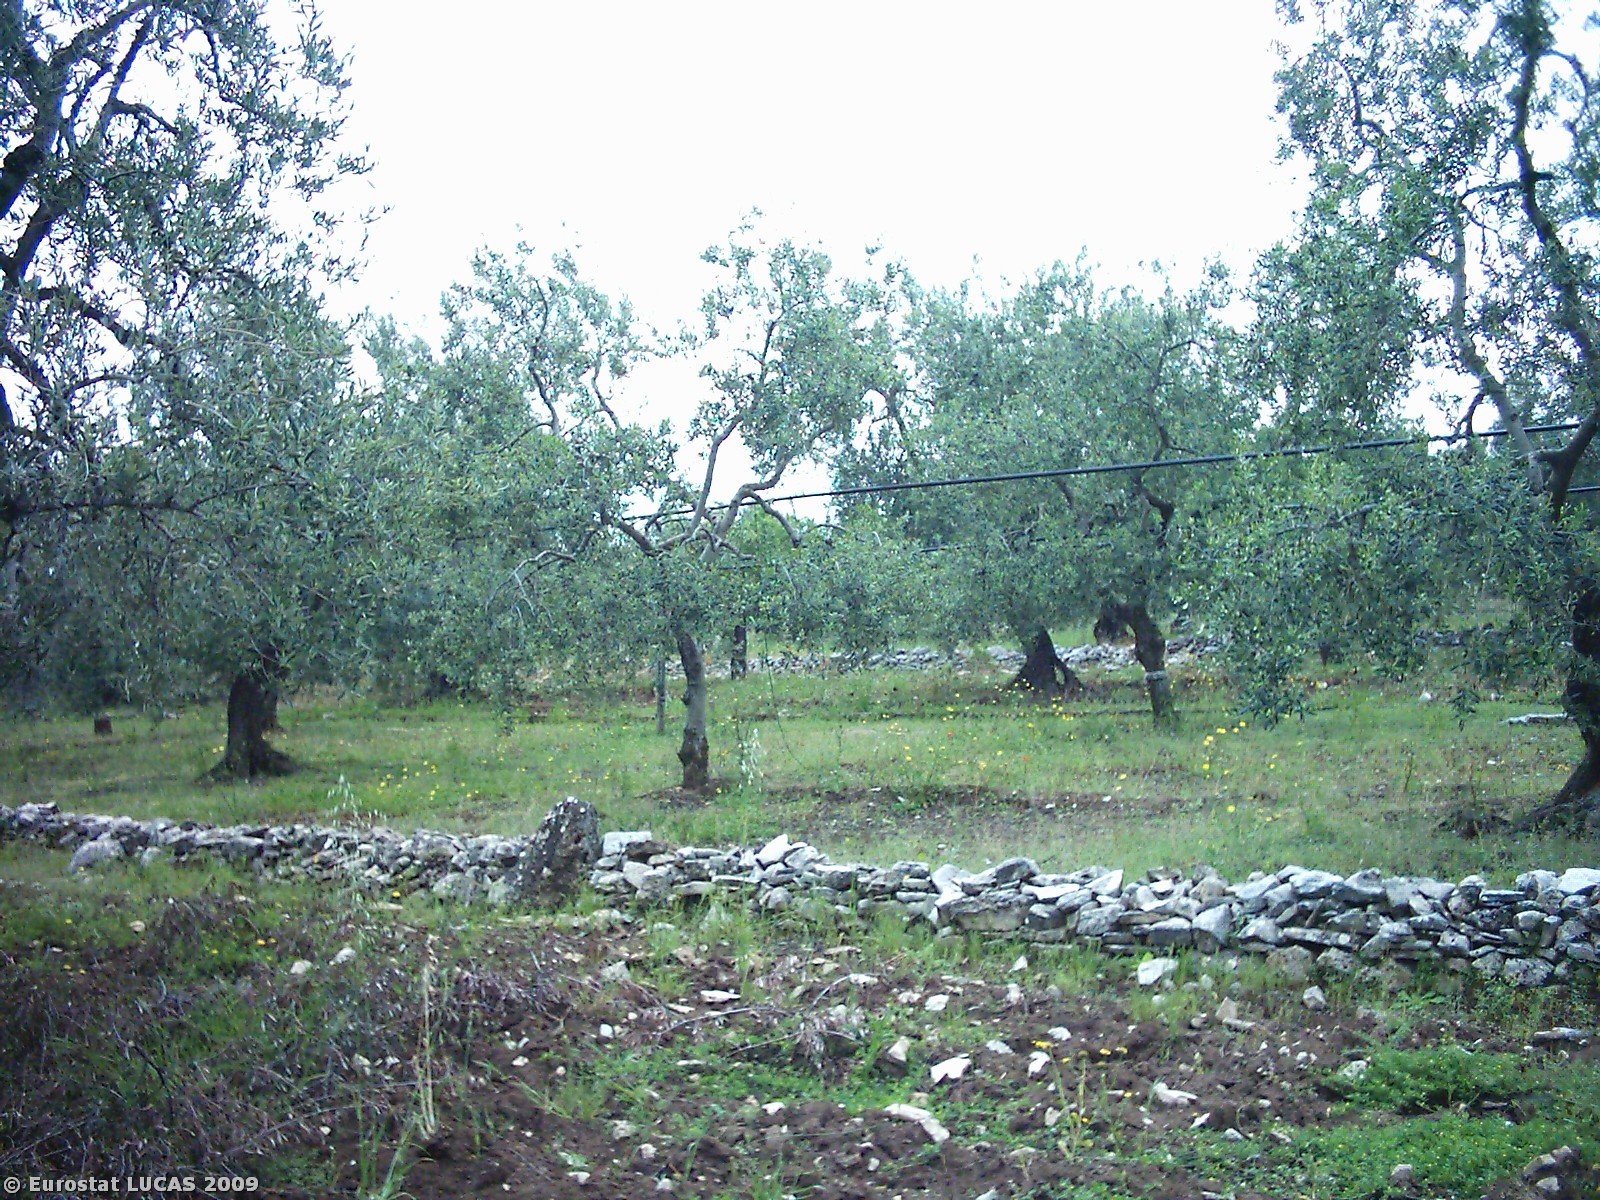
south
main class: Cropland
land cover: Olive groves
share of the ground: 25 - 50 %
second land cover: Bare land
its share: 50 - 75 %
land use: Agriculture (excluding fallow land and kitchen gardens)
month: April
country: IT
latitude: 41.2217
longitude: 16.3618
